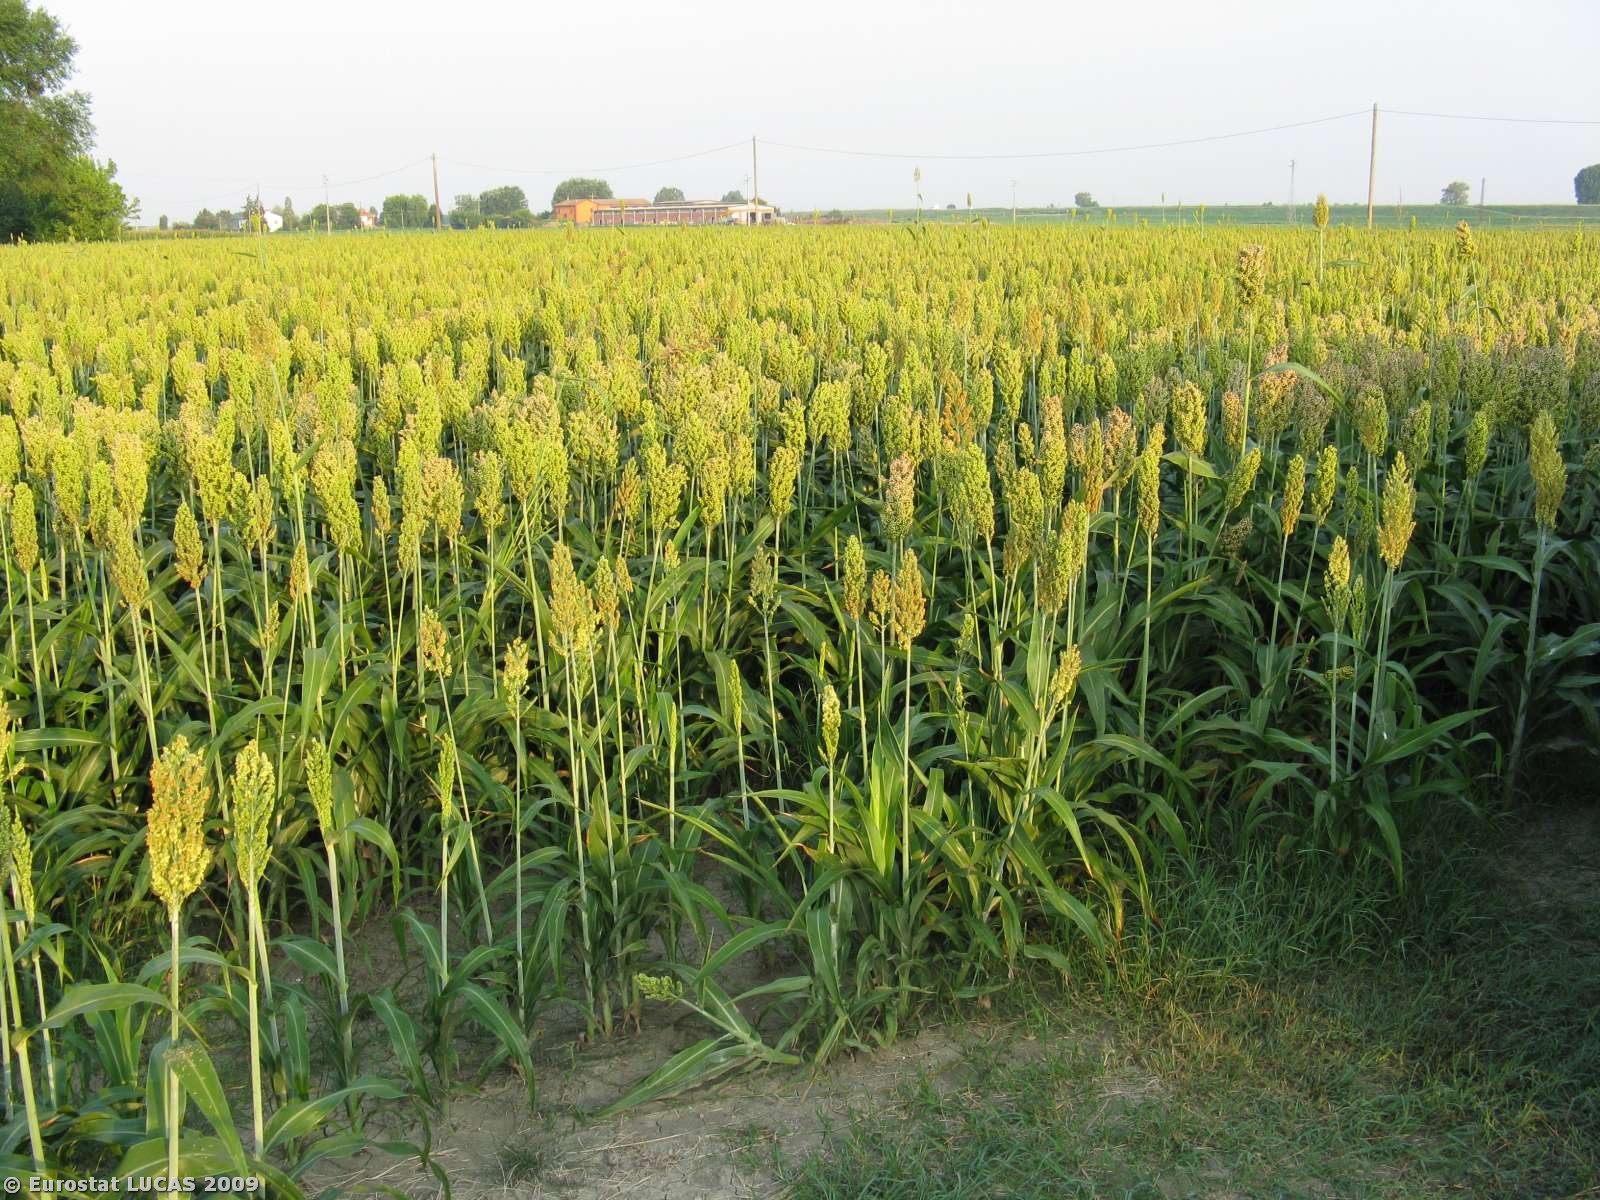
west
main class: Cropland
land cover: Other cereals
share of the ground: > 75 %
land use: Agriculture (excluding fallow land and kitchen gardens)
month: July
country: IT
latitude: 44.5708
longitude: 11.7215
